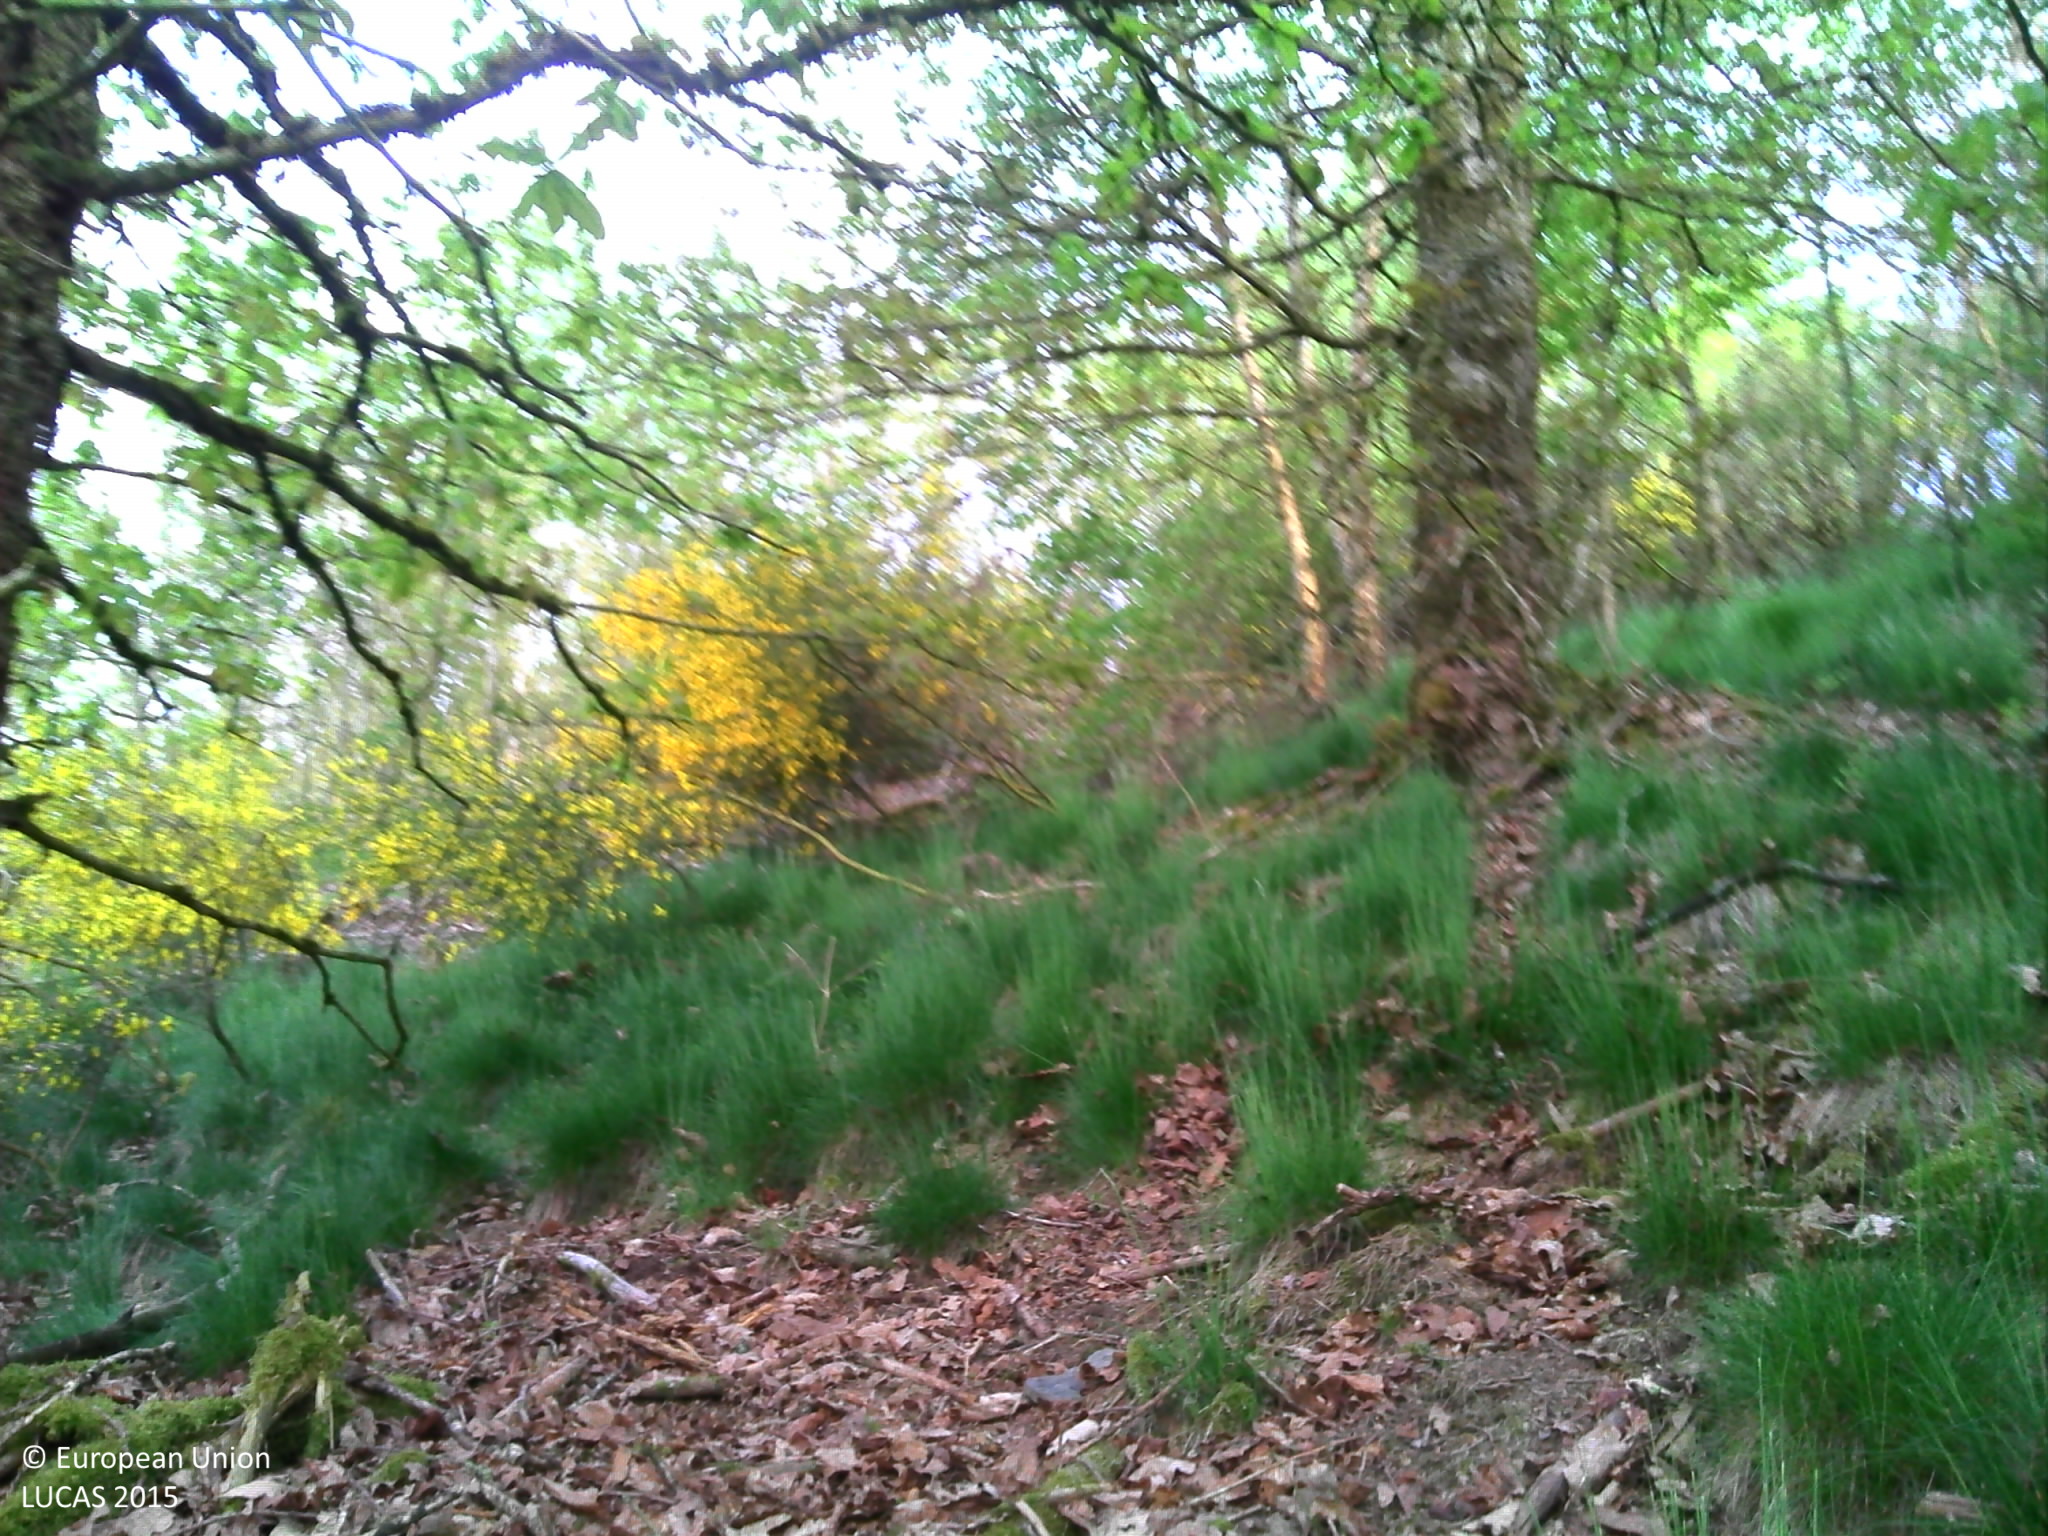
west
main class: Woodland
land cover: Broadleaved woodland
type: acidophilous oak and oak-birch forest
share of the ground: > 75 %
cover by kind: broadleaved forest trees 90 %, shrubs 5 %, herbaceous plants 5 %
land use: Forestry
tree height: > 5 m
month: May
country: LU
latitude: 50.0956
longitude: 5.9871
